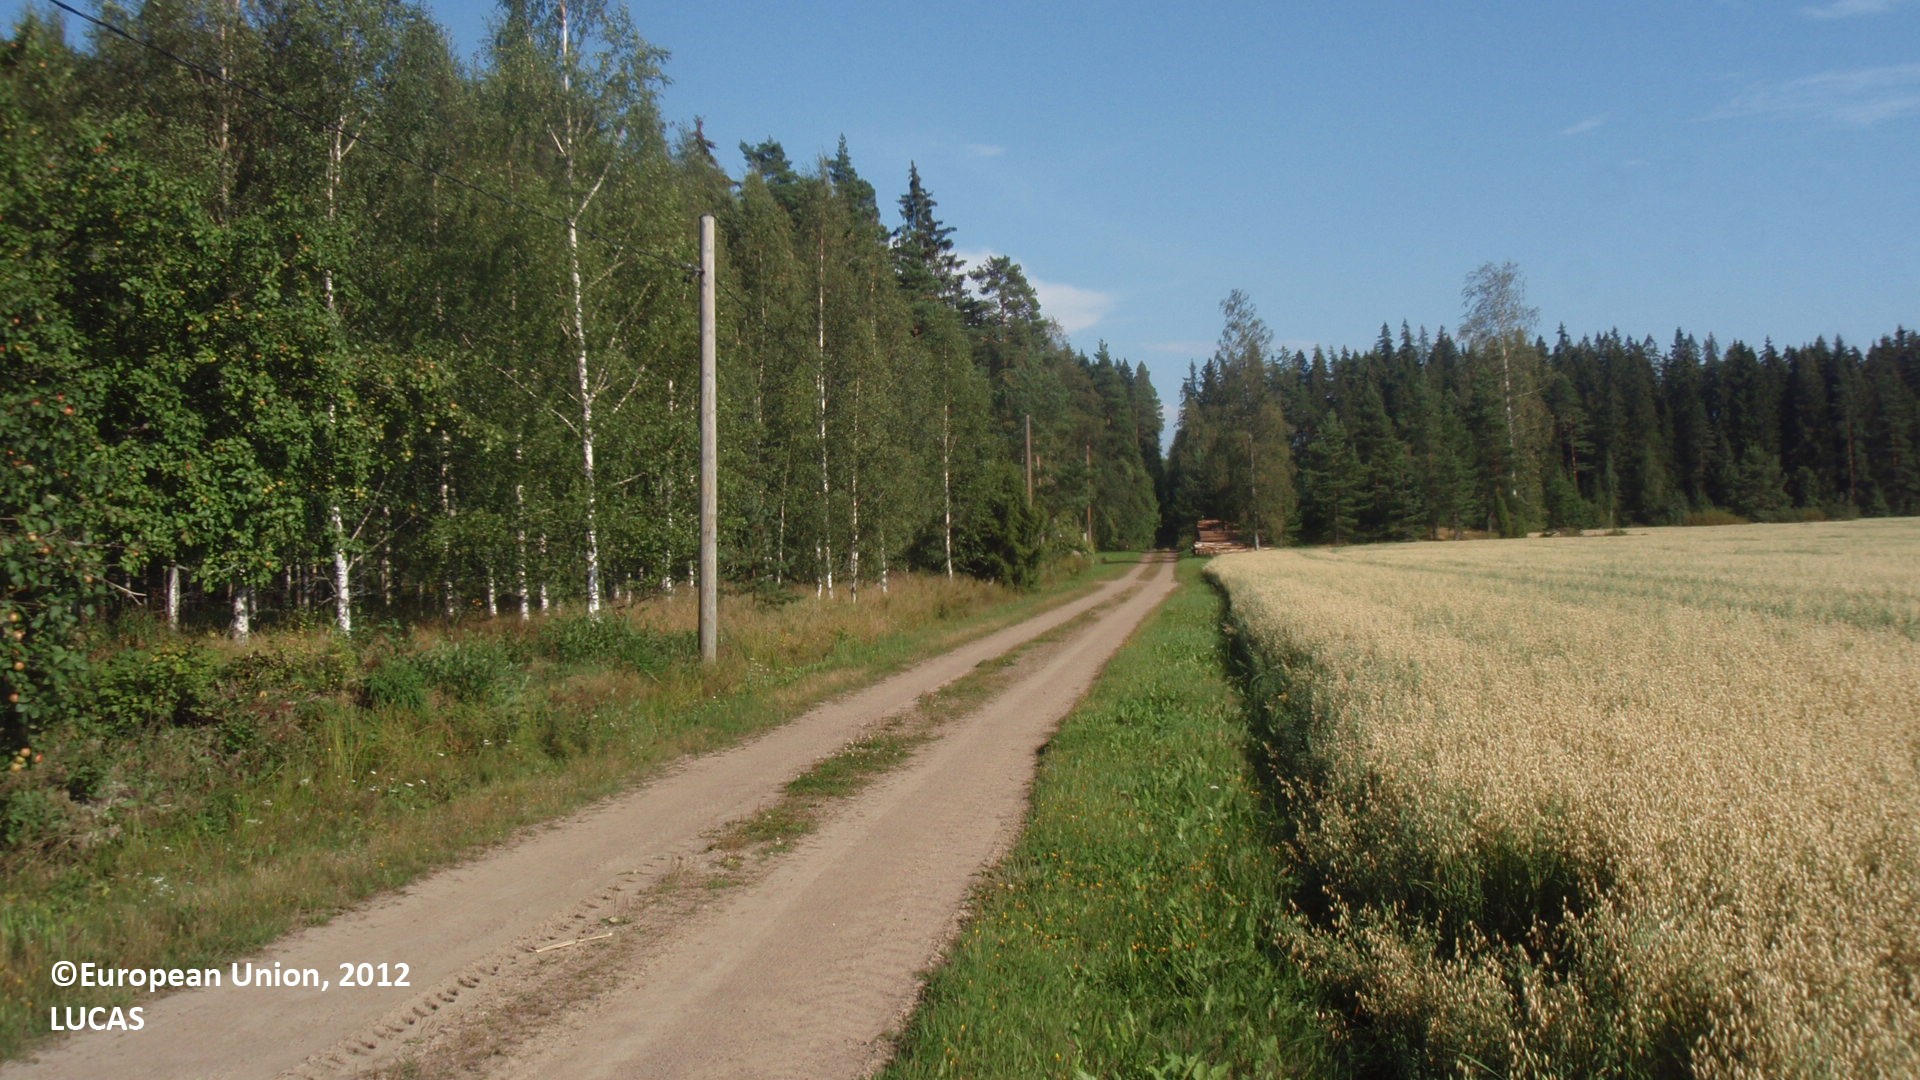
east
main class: Cropland
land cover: Oats
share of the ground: > 75 %
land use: Agriculture (excluding fallow land and kitchen gardens)
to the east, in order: Oats; Grass margins; Paved roads, cycling and walking lanes; Grass margins; Electric lines; Spruce dominated coniferous woodland; Artificial constructions in urban areas; Ditches and canals; Spruce dominated coniferous woodland
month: August
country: FI
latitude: 60.8104
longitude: 26.6080
